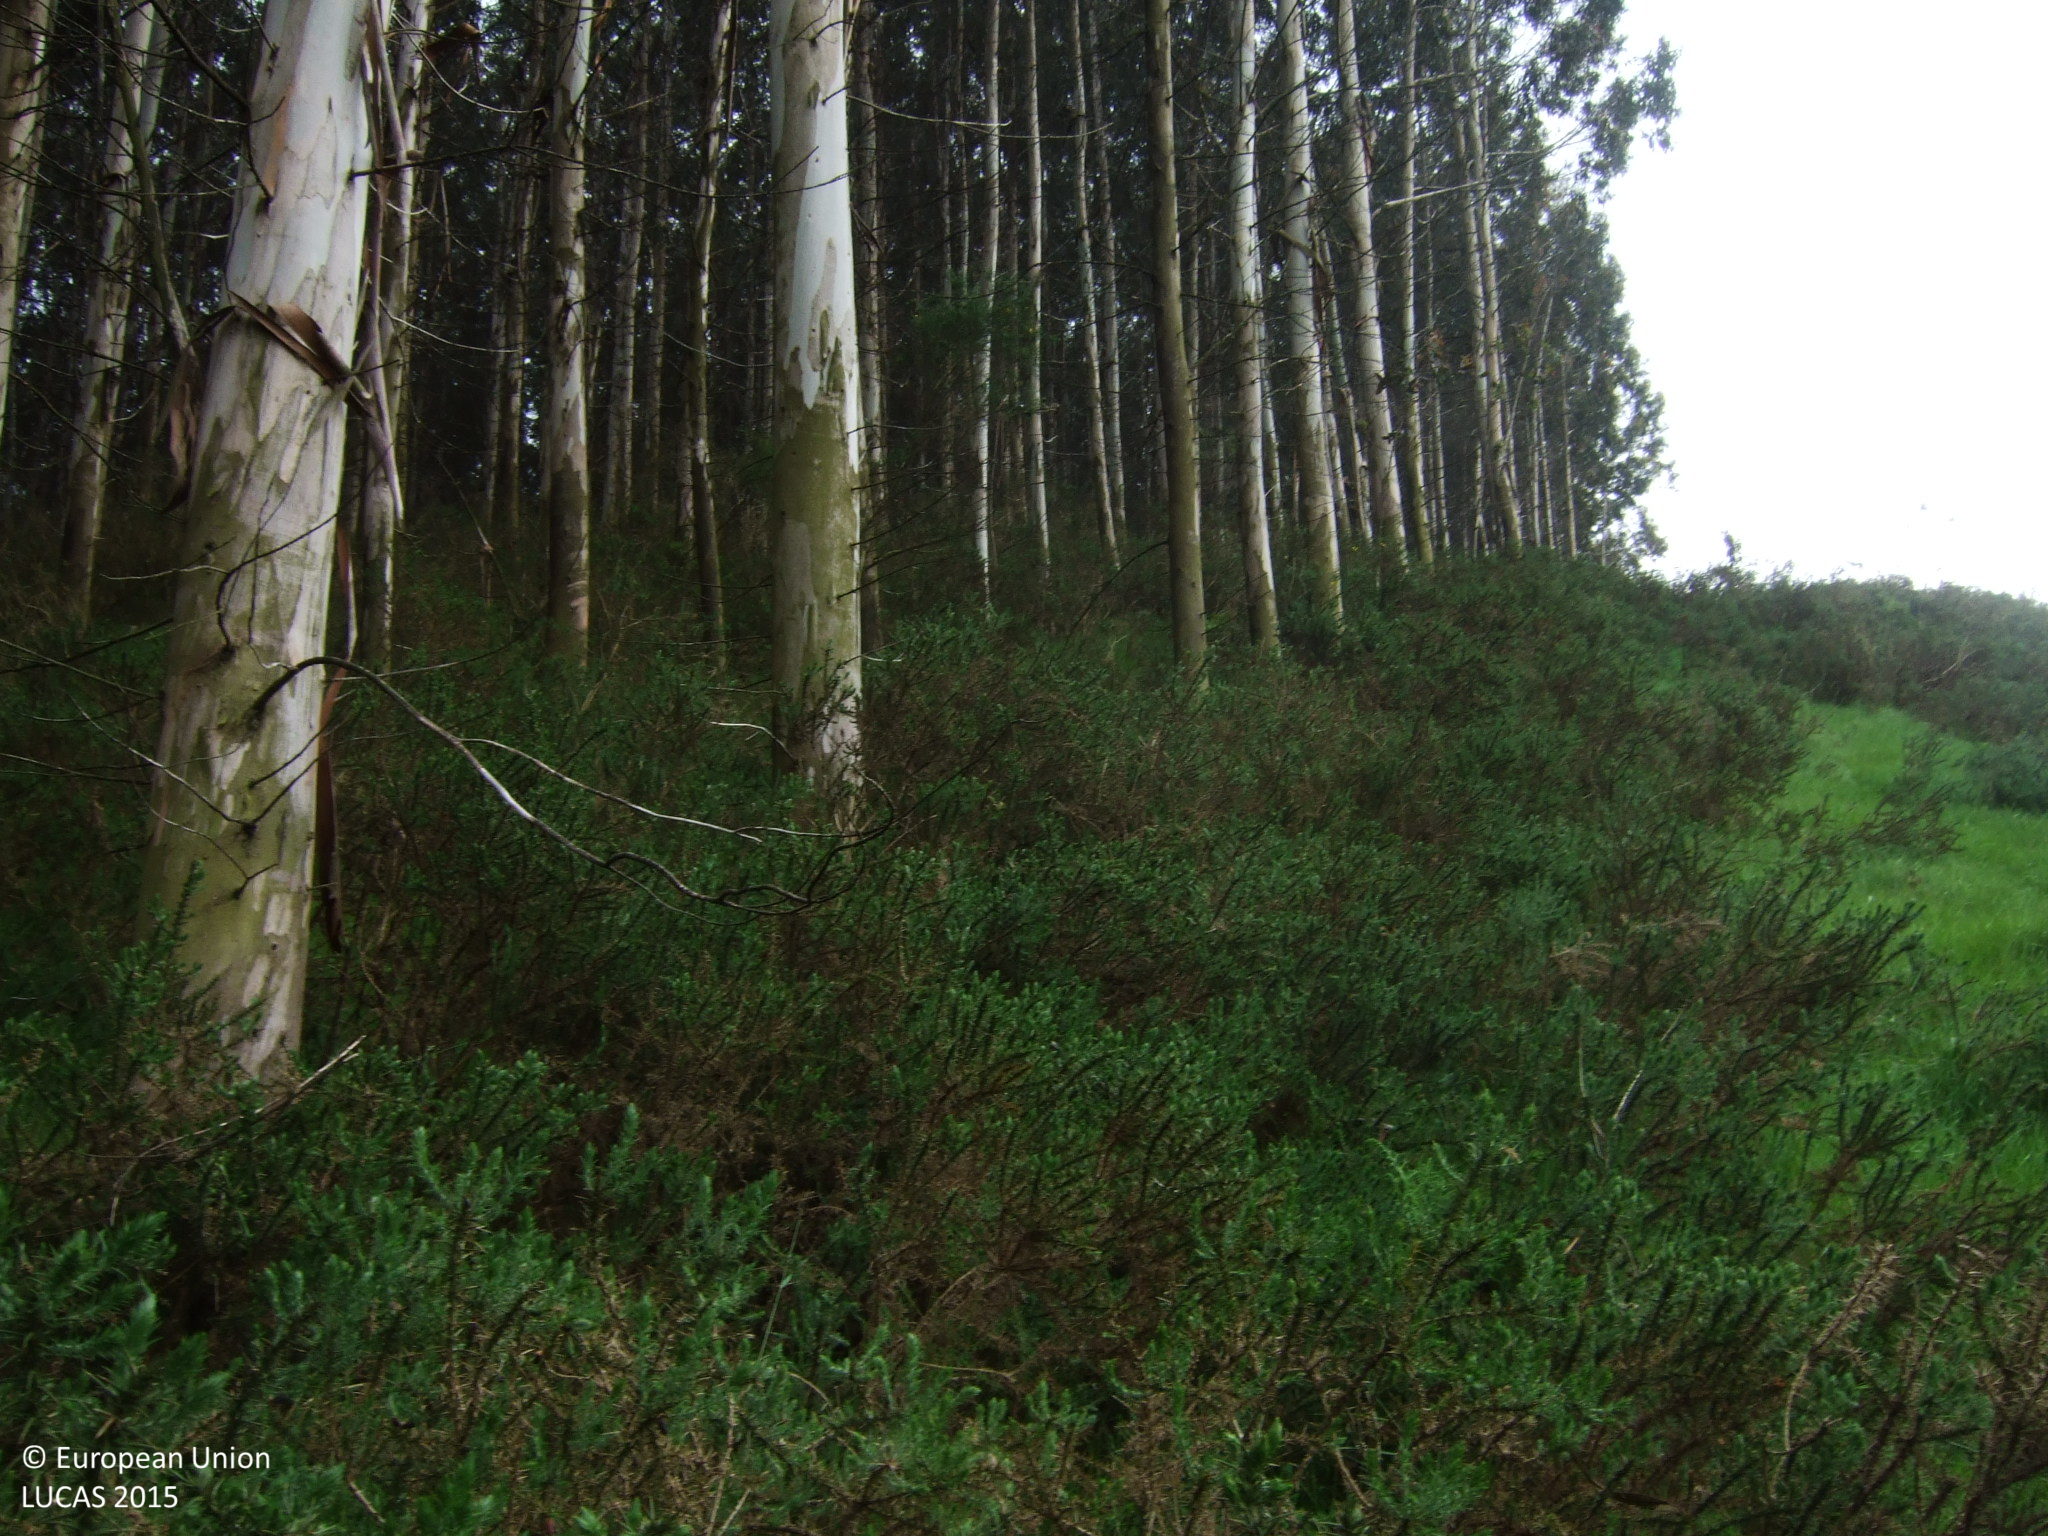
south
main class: Shrubland
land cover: Shrubland without tree cover
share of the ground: > 75 %
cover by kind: shrubs 90 %, herbaceous plants 10 %
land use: Semi-natural and natural areas not in use
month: June
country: ES
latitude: 43.3398
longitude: -7.4330
